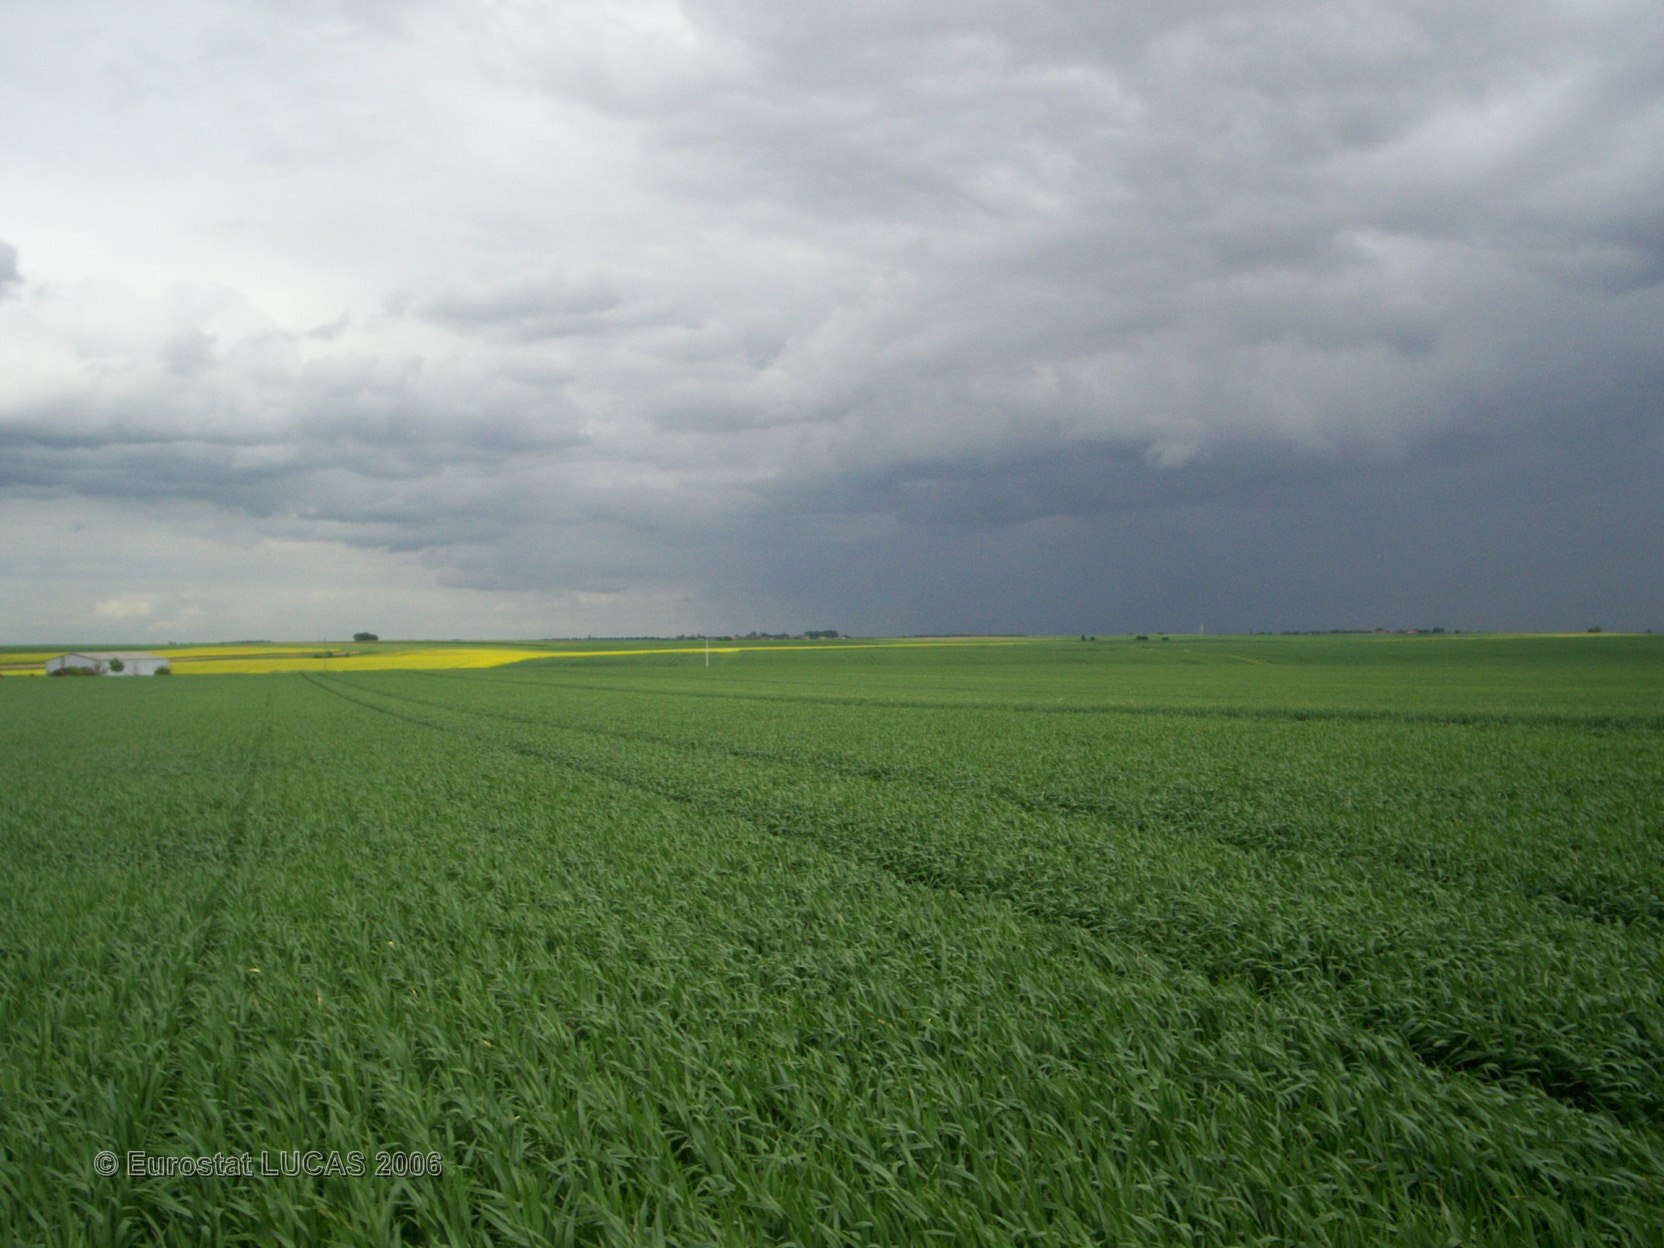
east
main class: Cropland
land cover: Common wheat
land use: Agriculture (excluding fallow land and kitchen gardens)
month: May
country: FR
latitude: 49.1256
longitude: 2.7957
